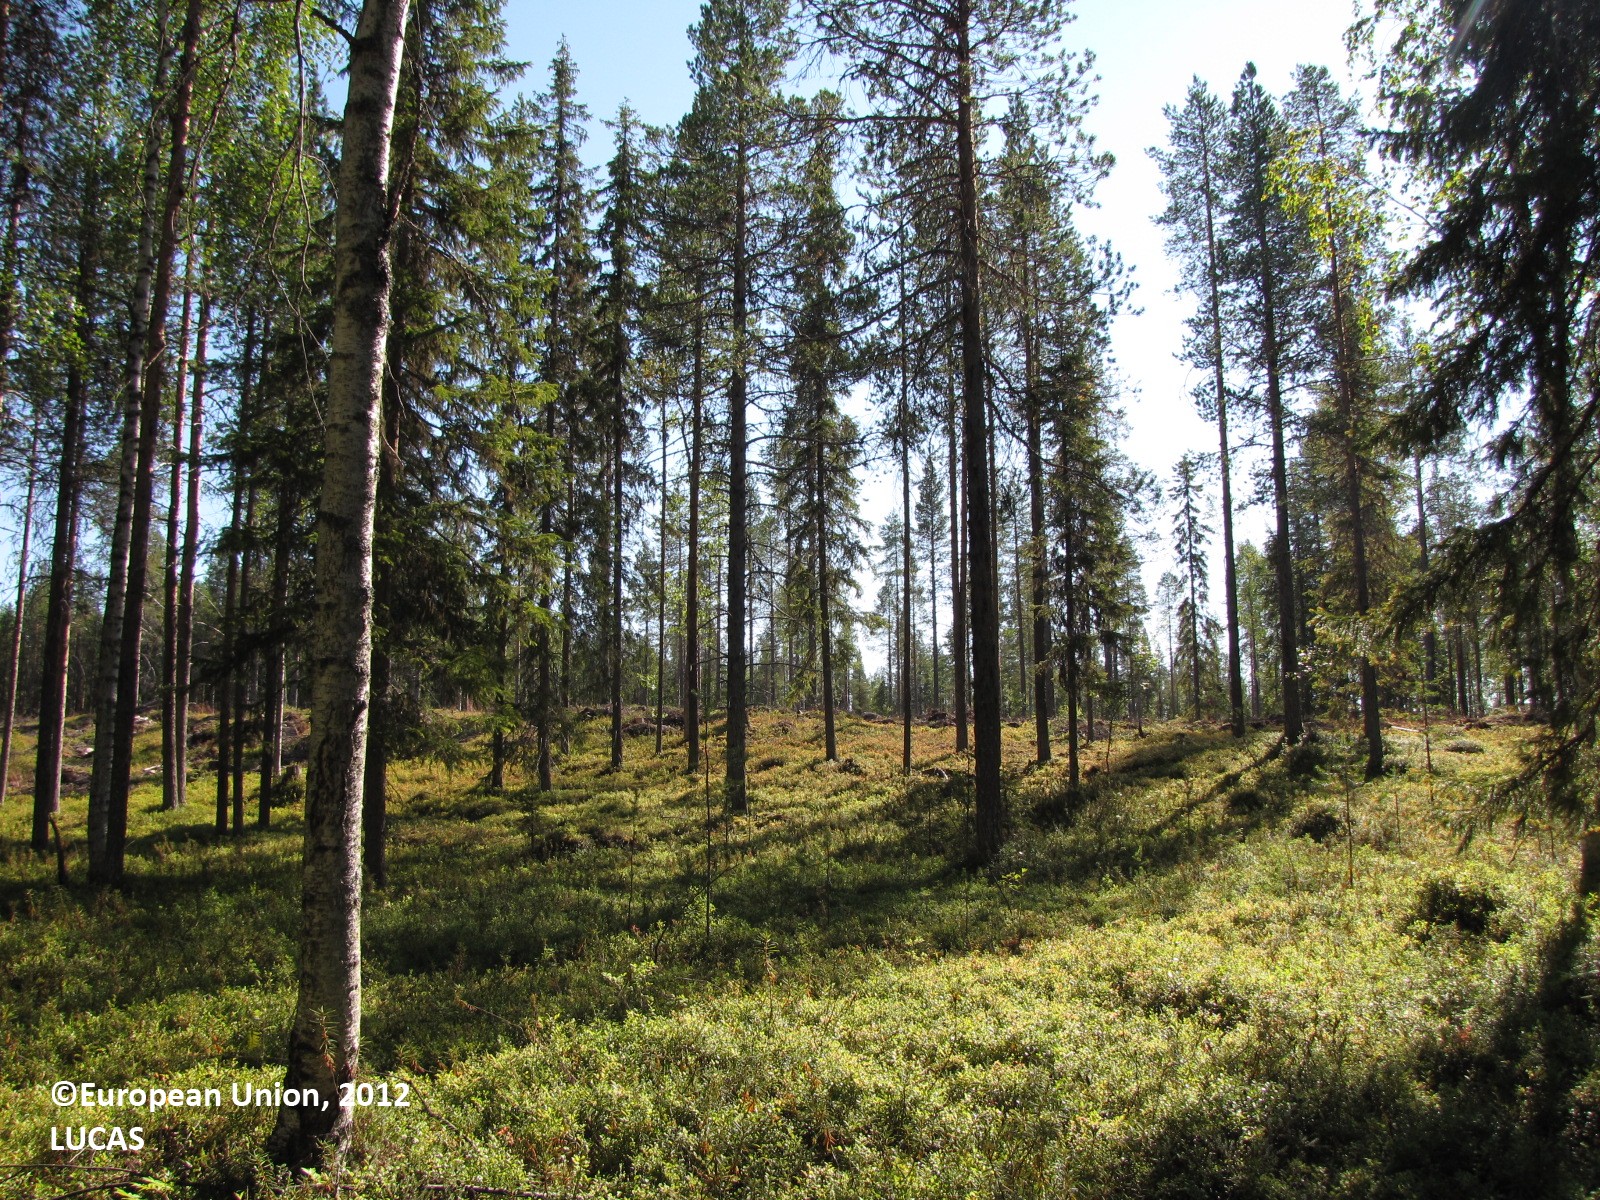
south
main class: Woodland
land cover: Other coniferous woodland
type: boreal forest
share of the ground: 50 - 75 %
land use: Forestry
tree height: > 5 m
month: August
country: FI
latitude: 66.9329
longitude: 25.2157
